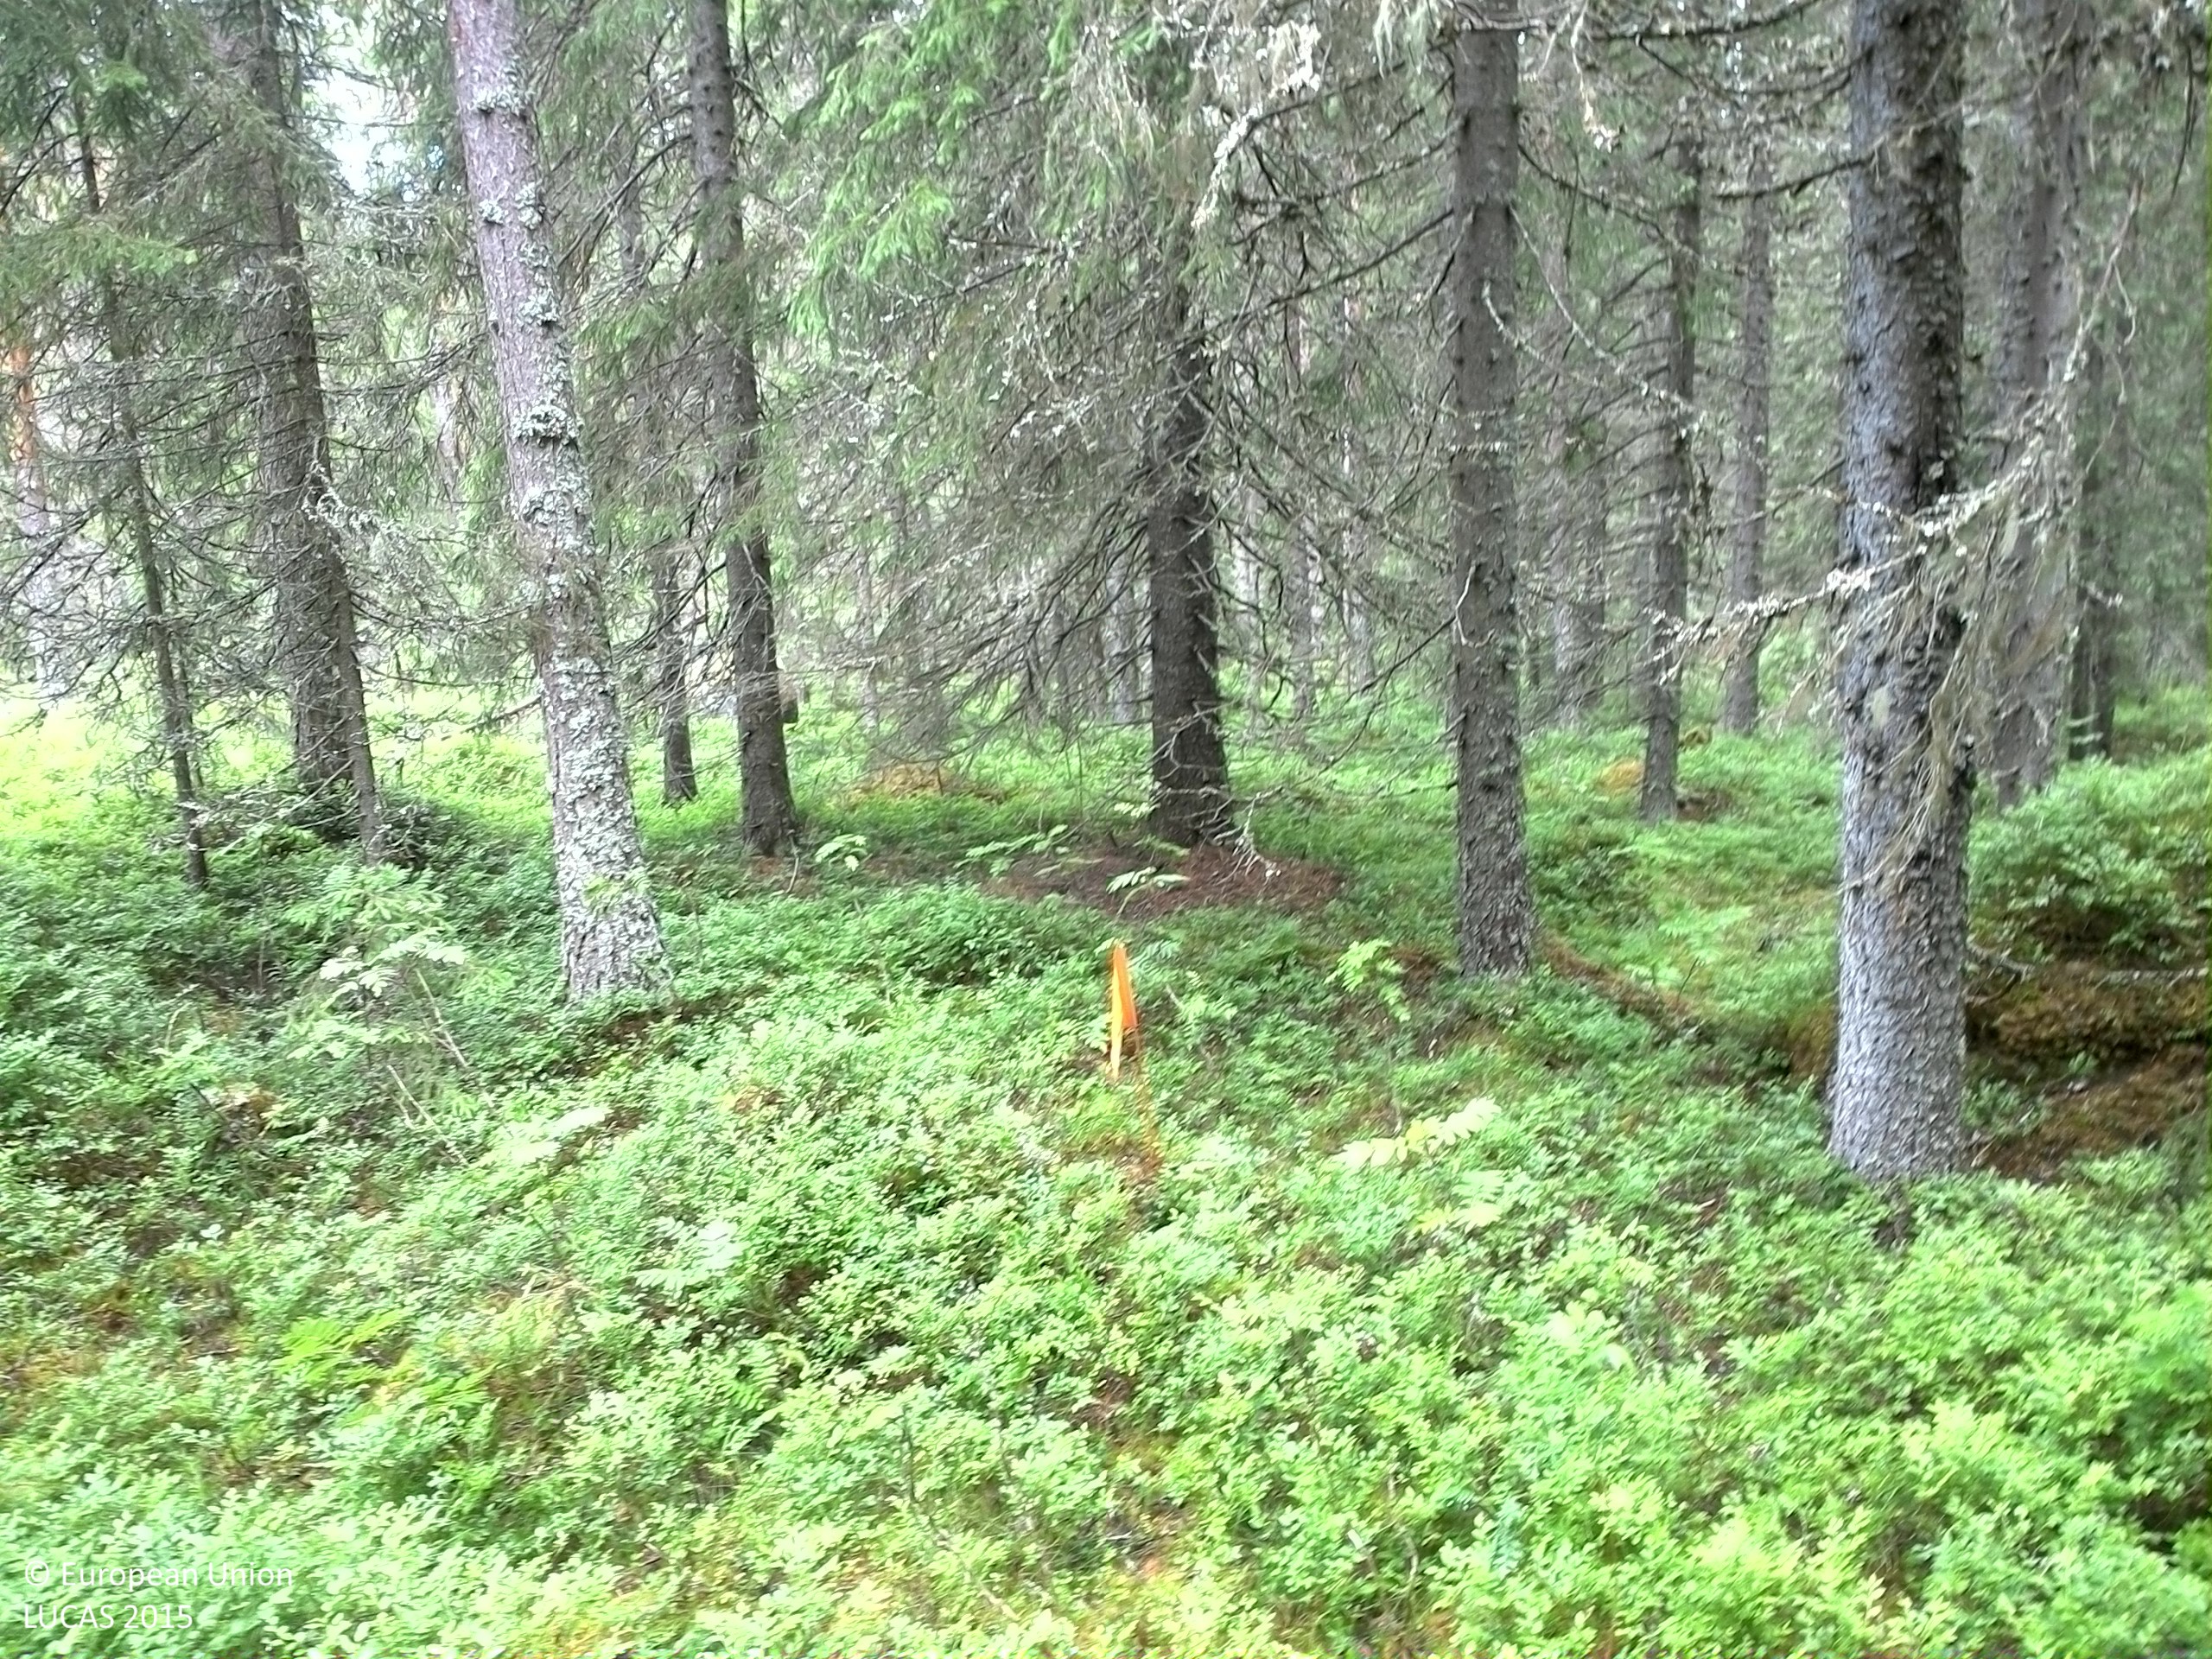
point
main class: Woodland
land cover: Spruce dominated coniferous woodland
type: boreal forest
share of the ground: 50 - 75 %
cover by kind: coniferous forest trees 60 %, shrubs 30 %, broadleaved forest trees 5 %, lichens and mosses 5 %
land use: Forestry
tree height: > 5 m
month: July
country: SE
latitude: 63.5619
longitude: 18.6527
